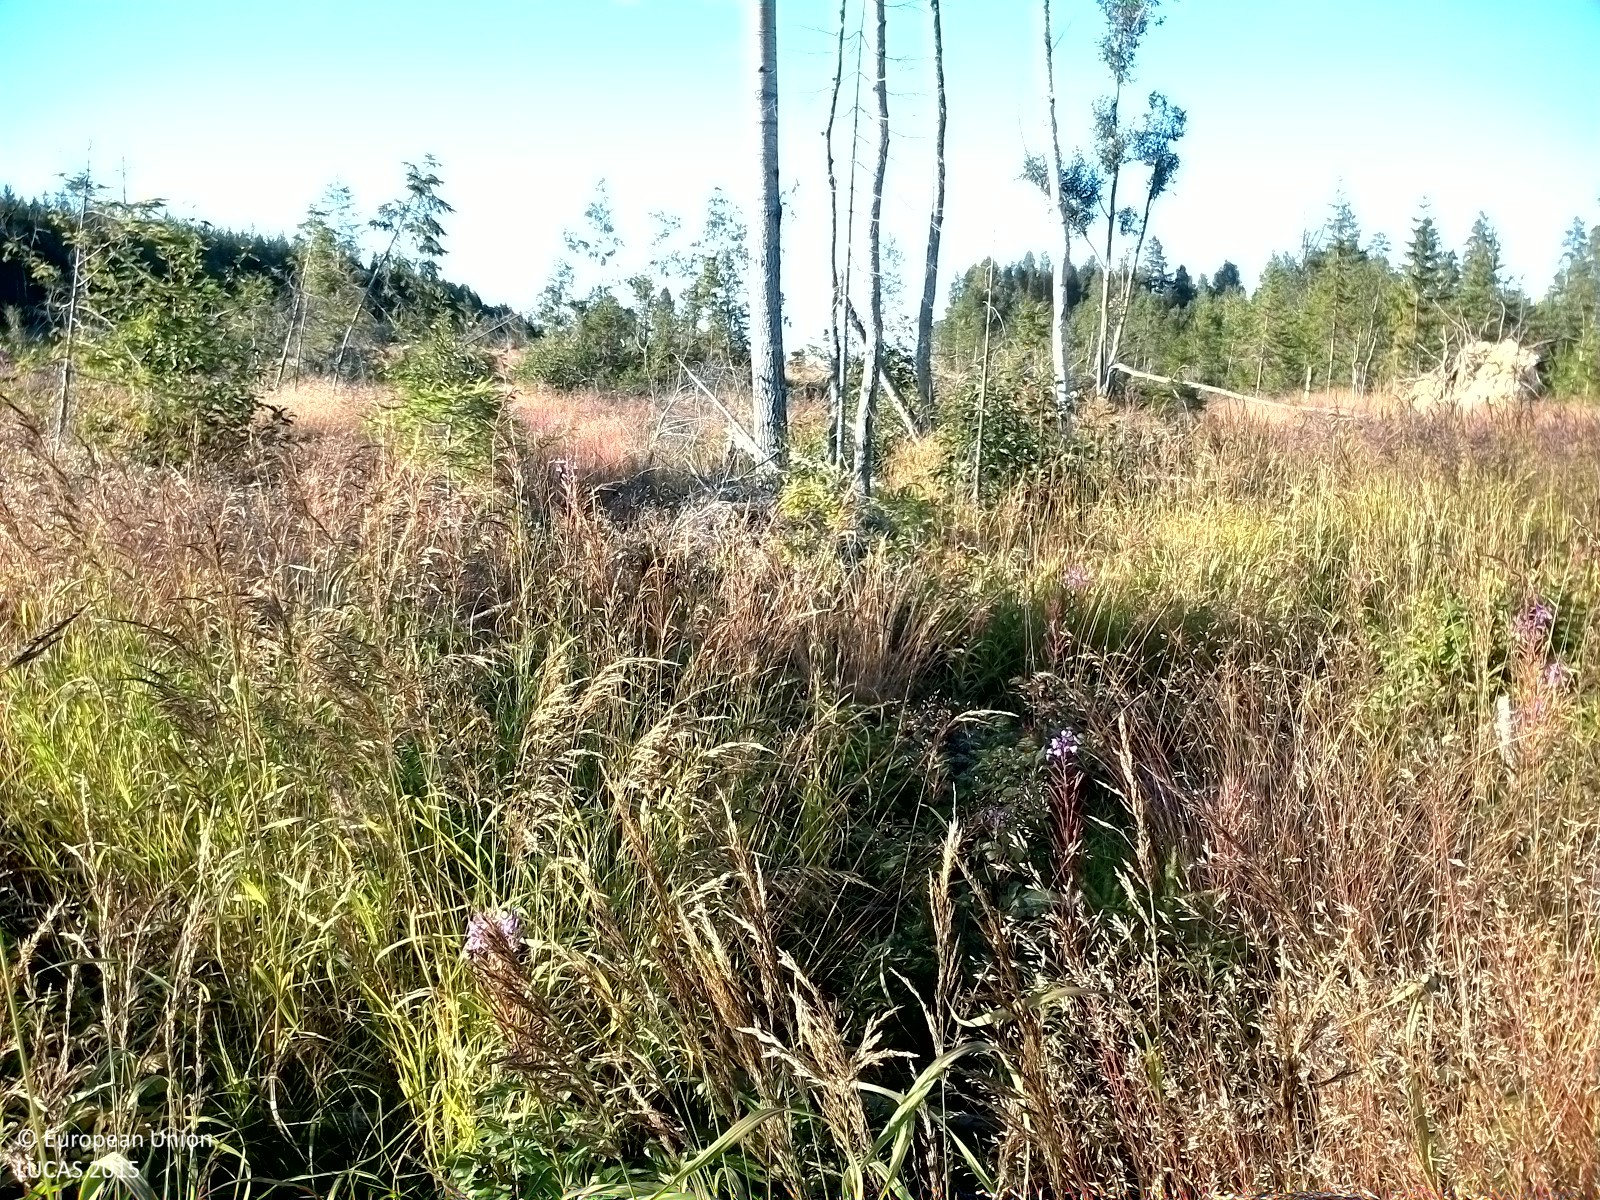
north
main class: Grassland
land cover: Grassland with sparse tree/shrub cover
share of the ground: > 75 %
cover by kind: herbaceous plants 90 %, broadleaved forest trees 5 %, unconsolidated bare surface 5 %
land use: Forestry
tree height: < 5 m
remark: Clear cut
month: August
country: SE
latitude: 62.3654
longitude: 16.4539
